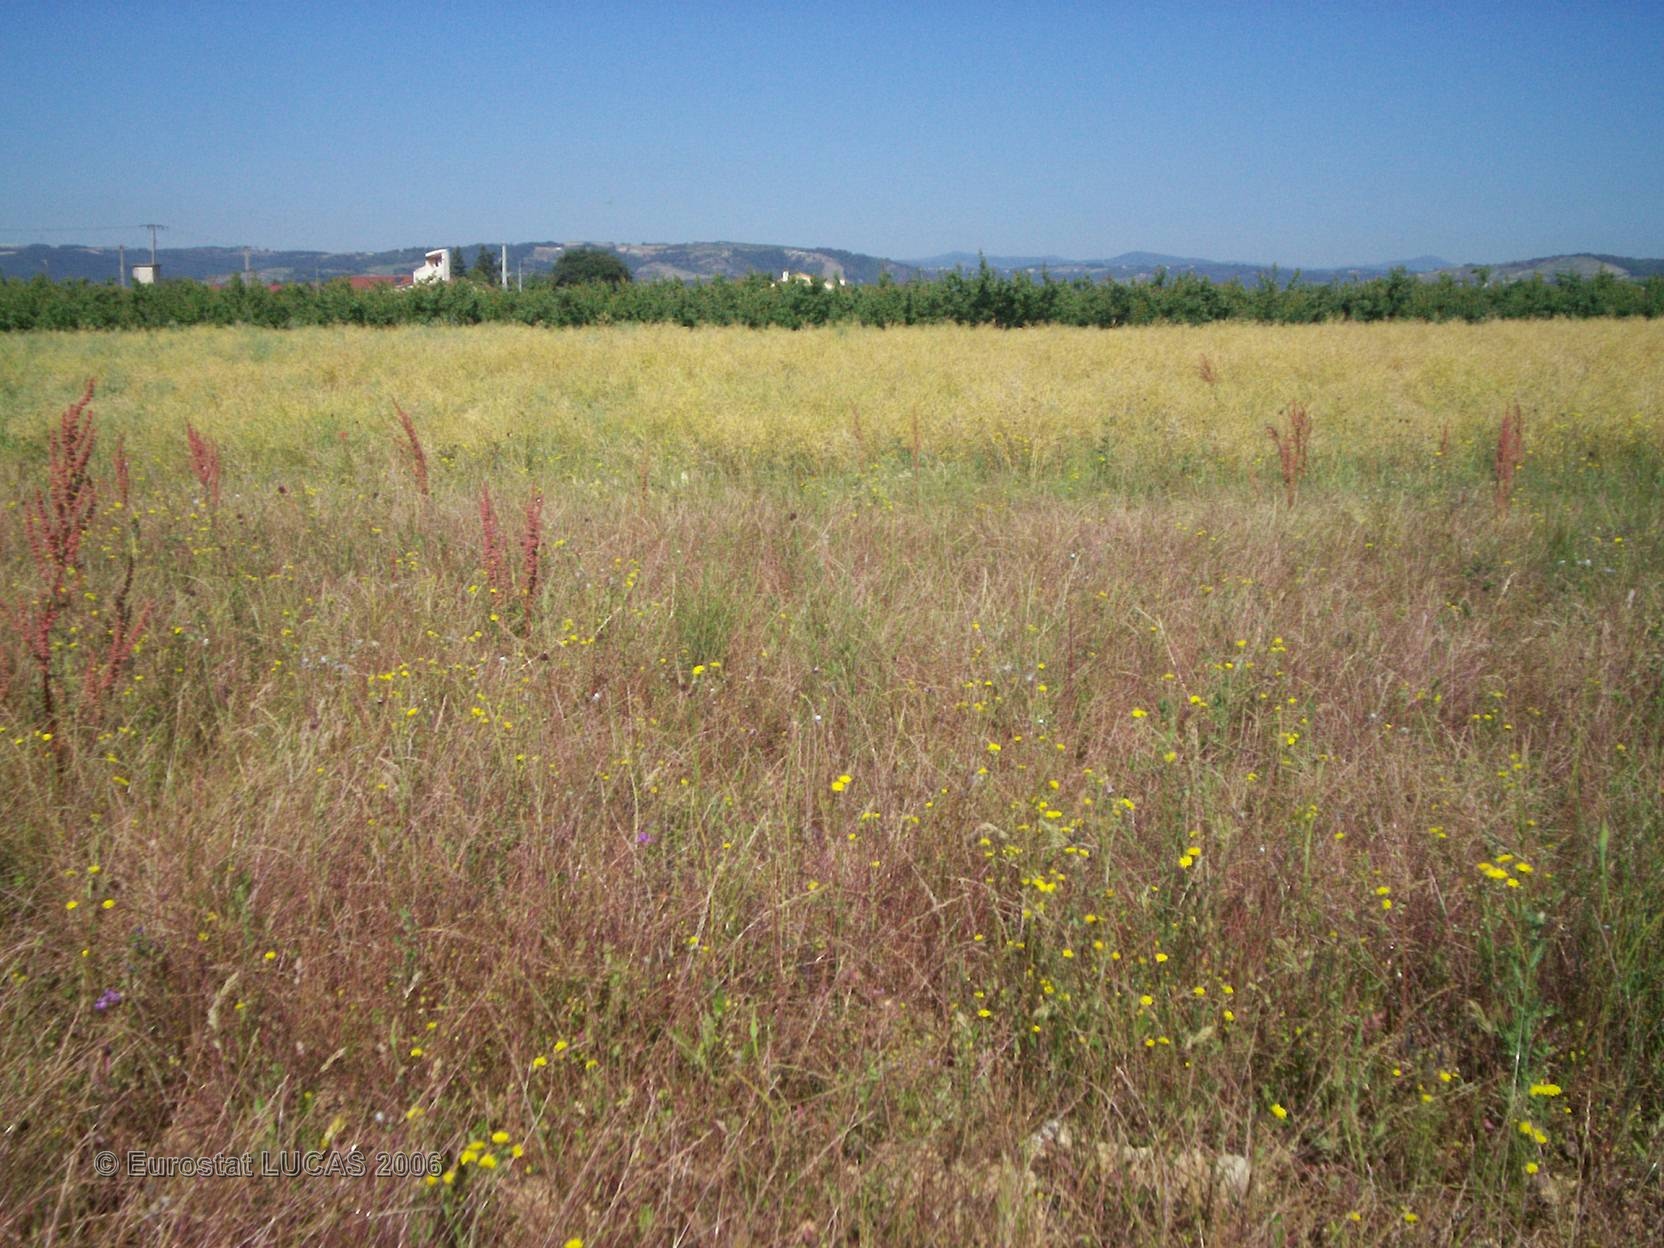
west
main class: Grassland
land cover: Grassland without tree/shrub cover
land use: Fallow land
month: June
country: FR
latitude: 45.0556
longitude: 4.8880
